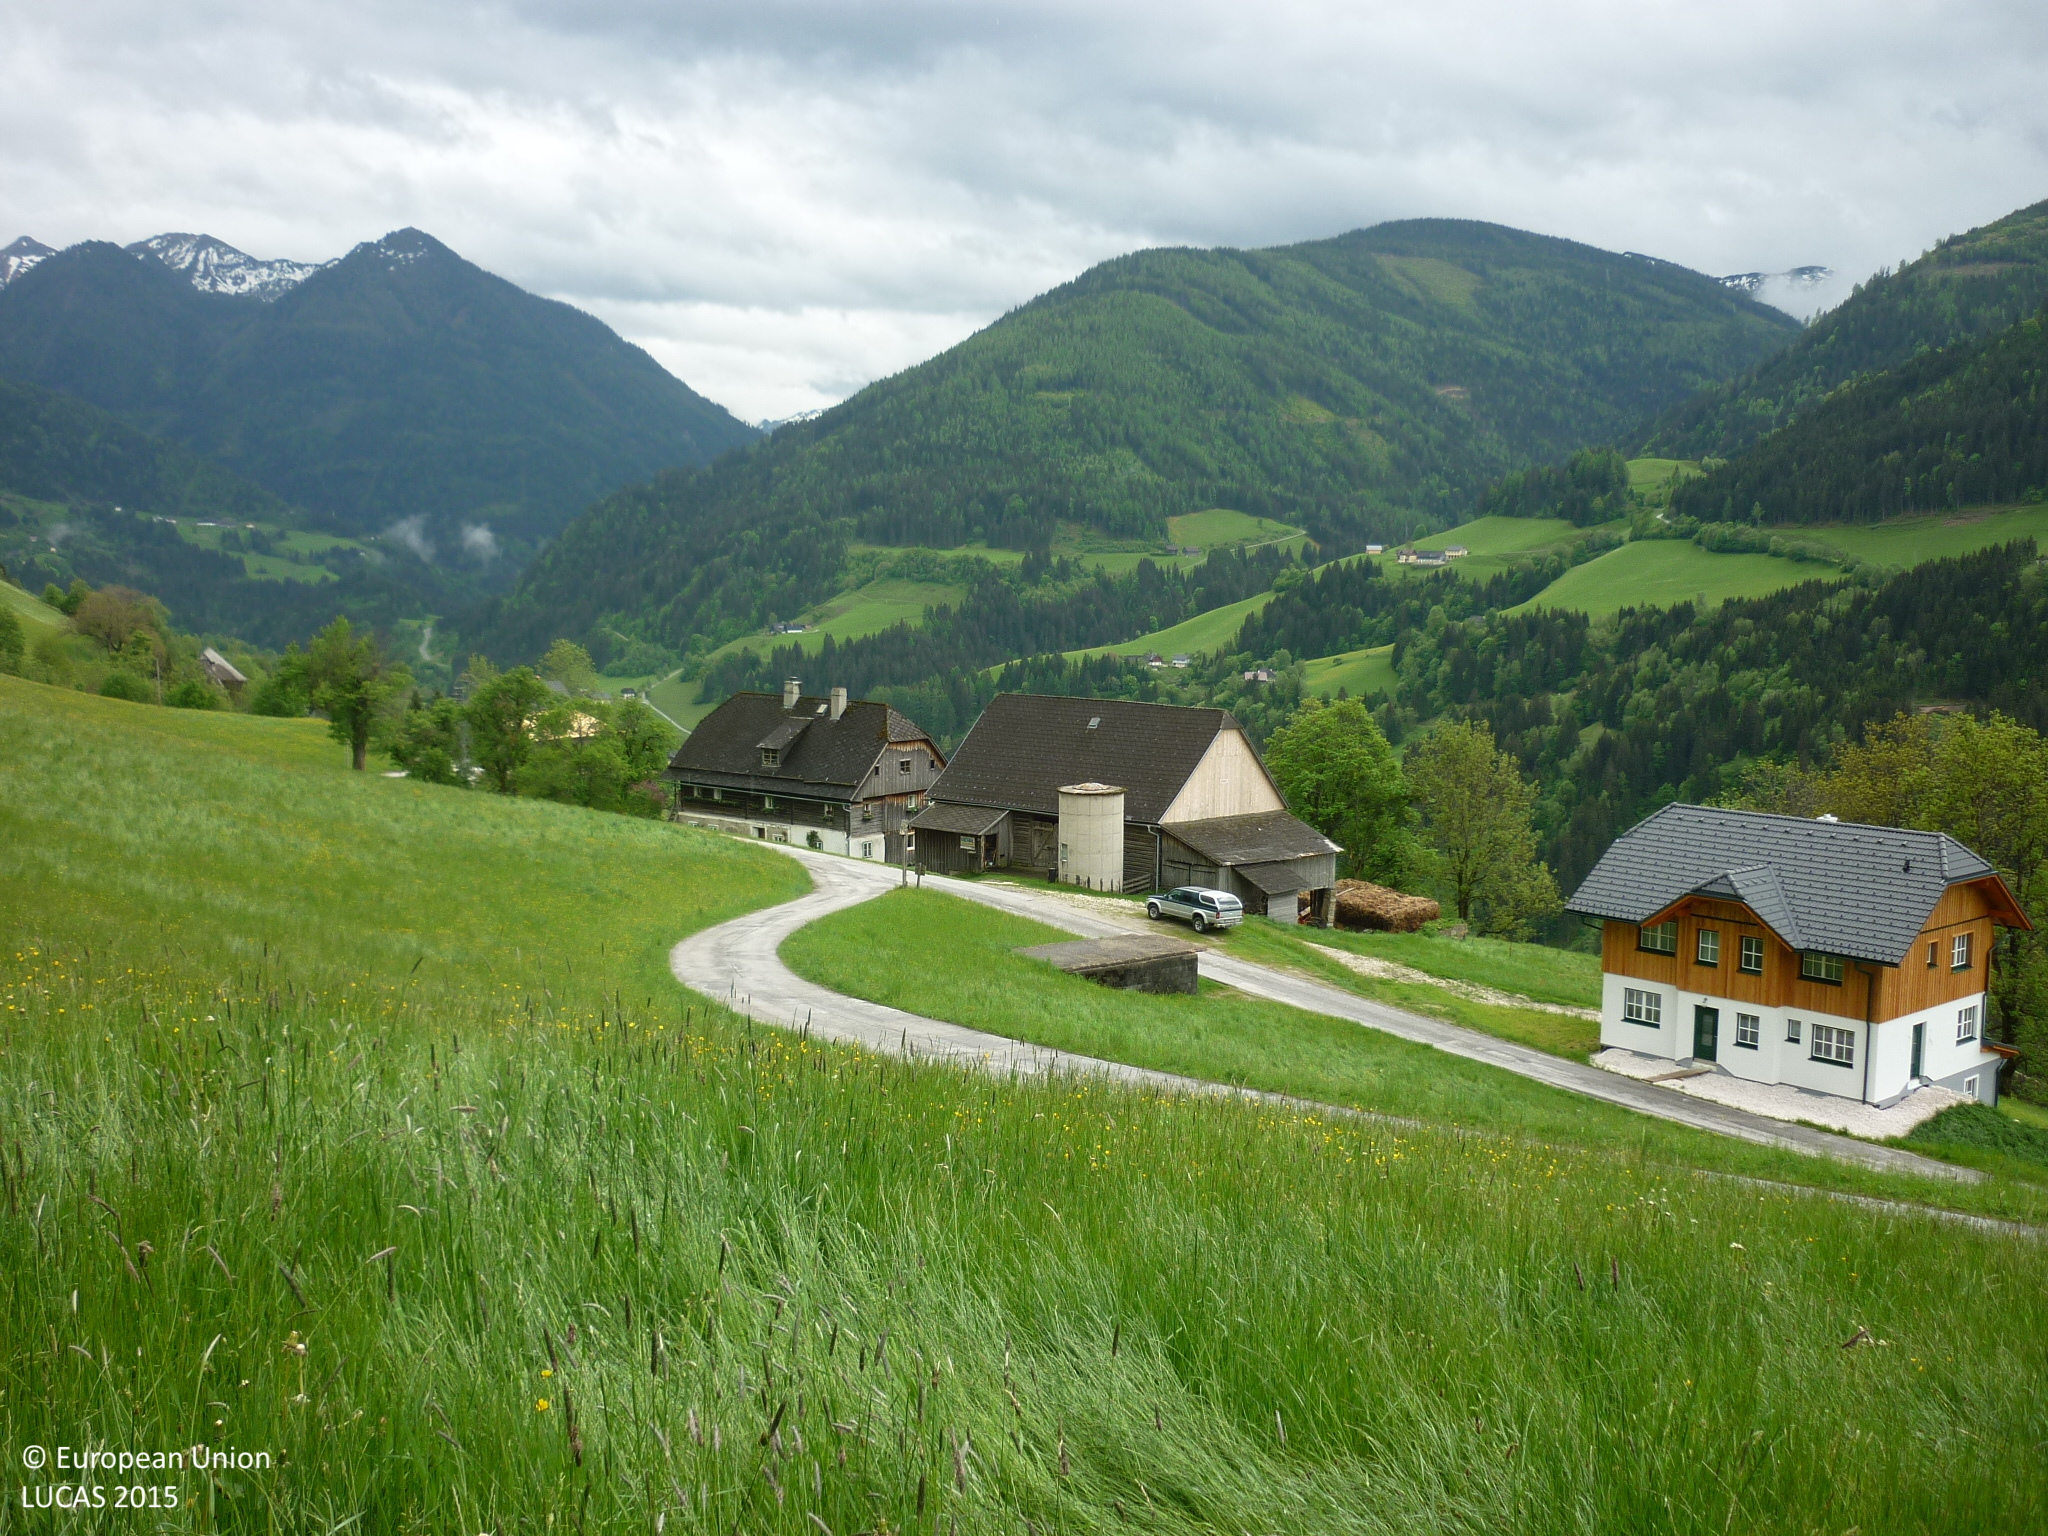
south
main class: Grassland
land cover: Grassland without tree/shrub cover
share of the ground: > 75 %
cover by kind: herbaceous plants 100 %
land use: Agriculture (excluding fallow land and kitchen gardens)
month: May
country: AT
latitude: 47.4796
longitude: 14.1258
